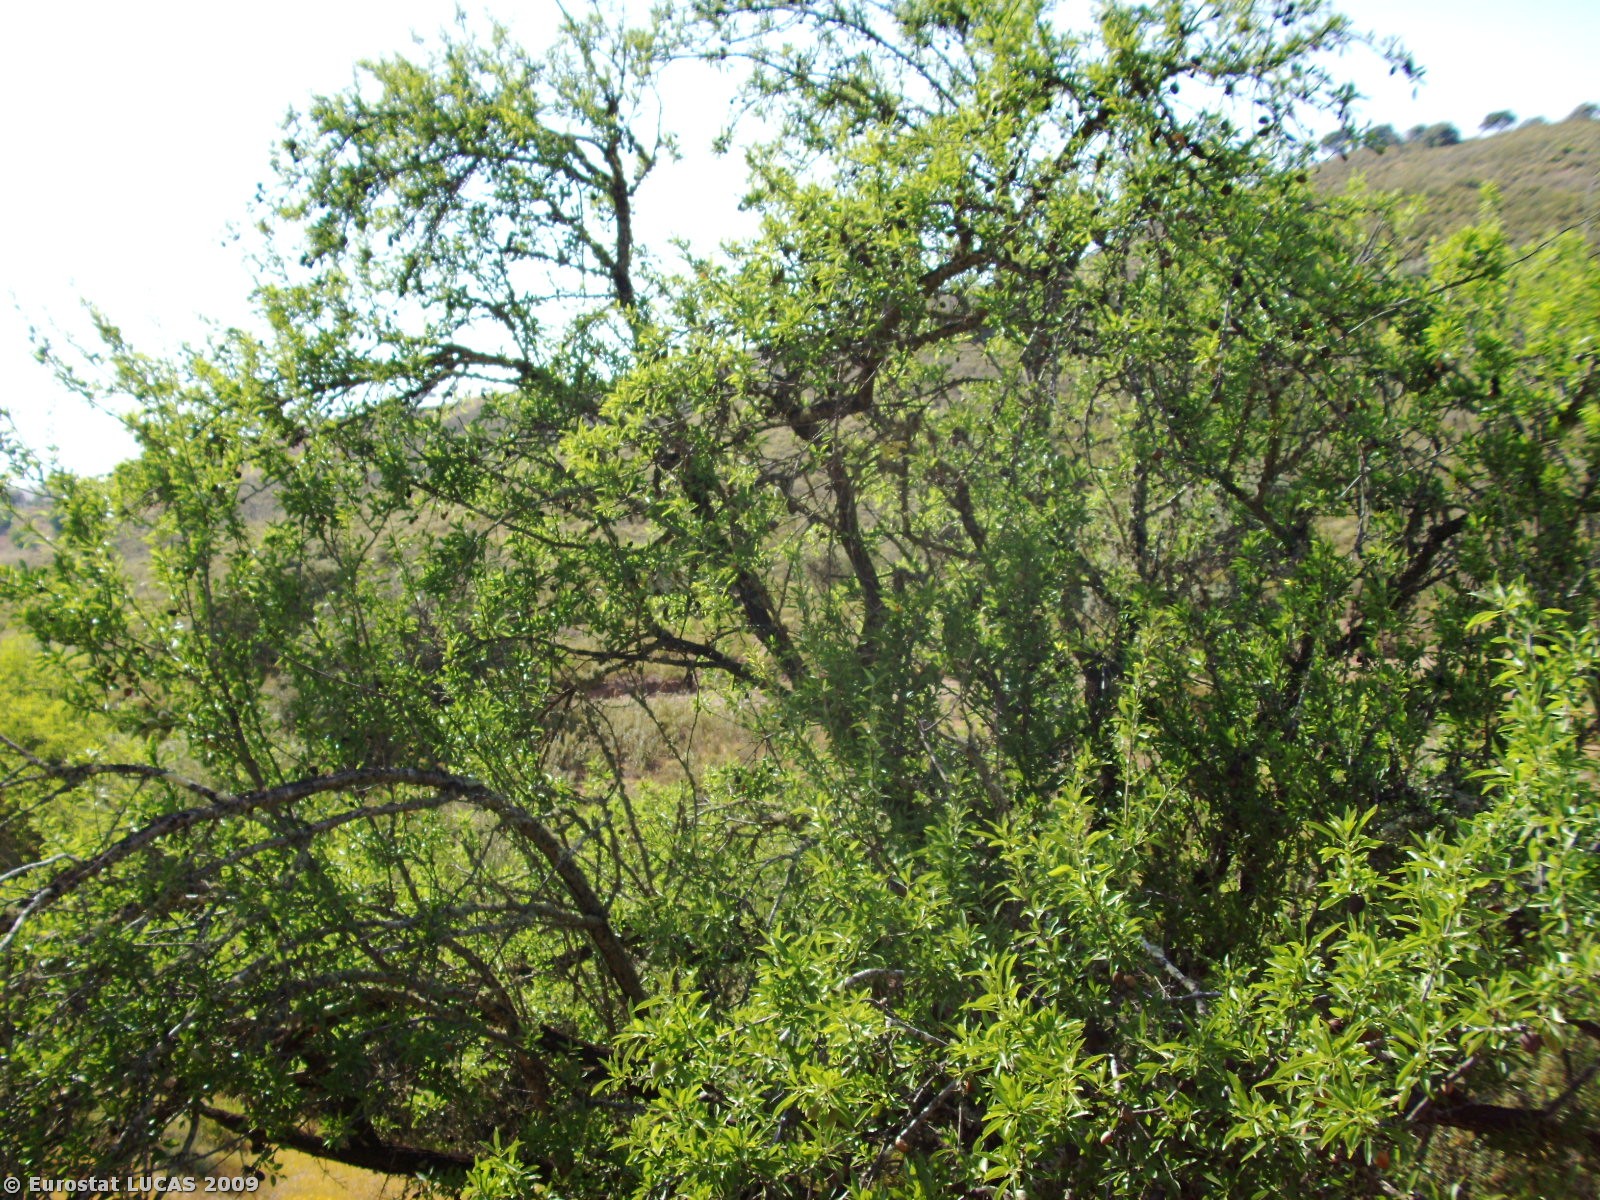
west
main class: Cropland
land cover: Nuts trees
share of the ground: < 10 %
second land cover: Spontaneously vegetated surfaces
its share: > 75 %
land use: Agriculture (excluding fallow land and kitchen gardens)
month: May
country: PT
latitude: 37.3910
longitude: -7.4801
